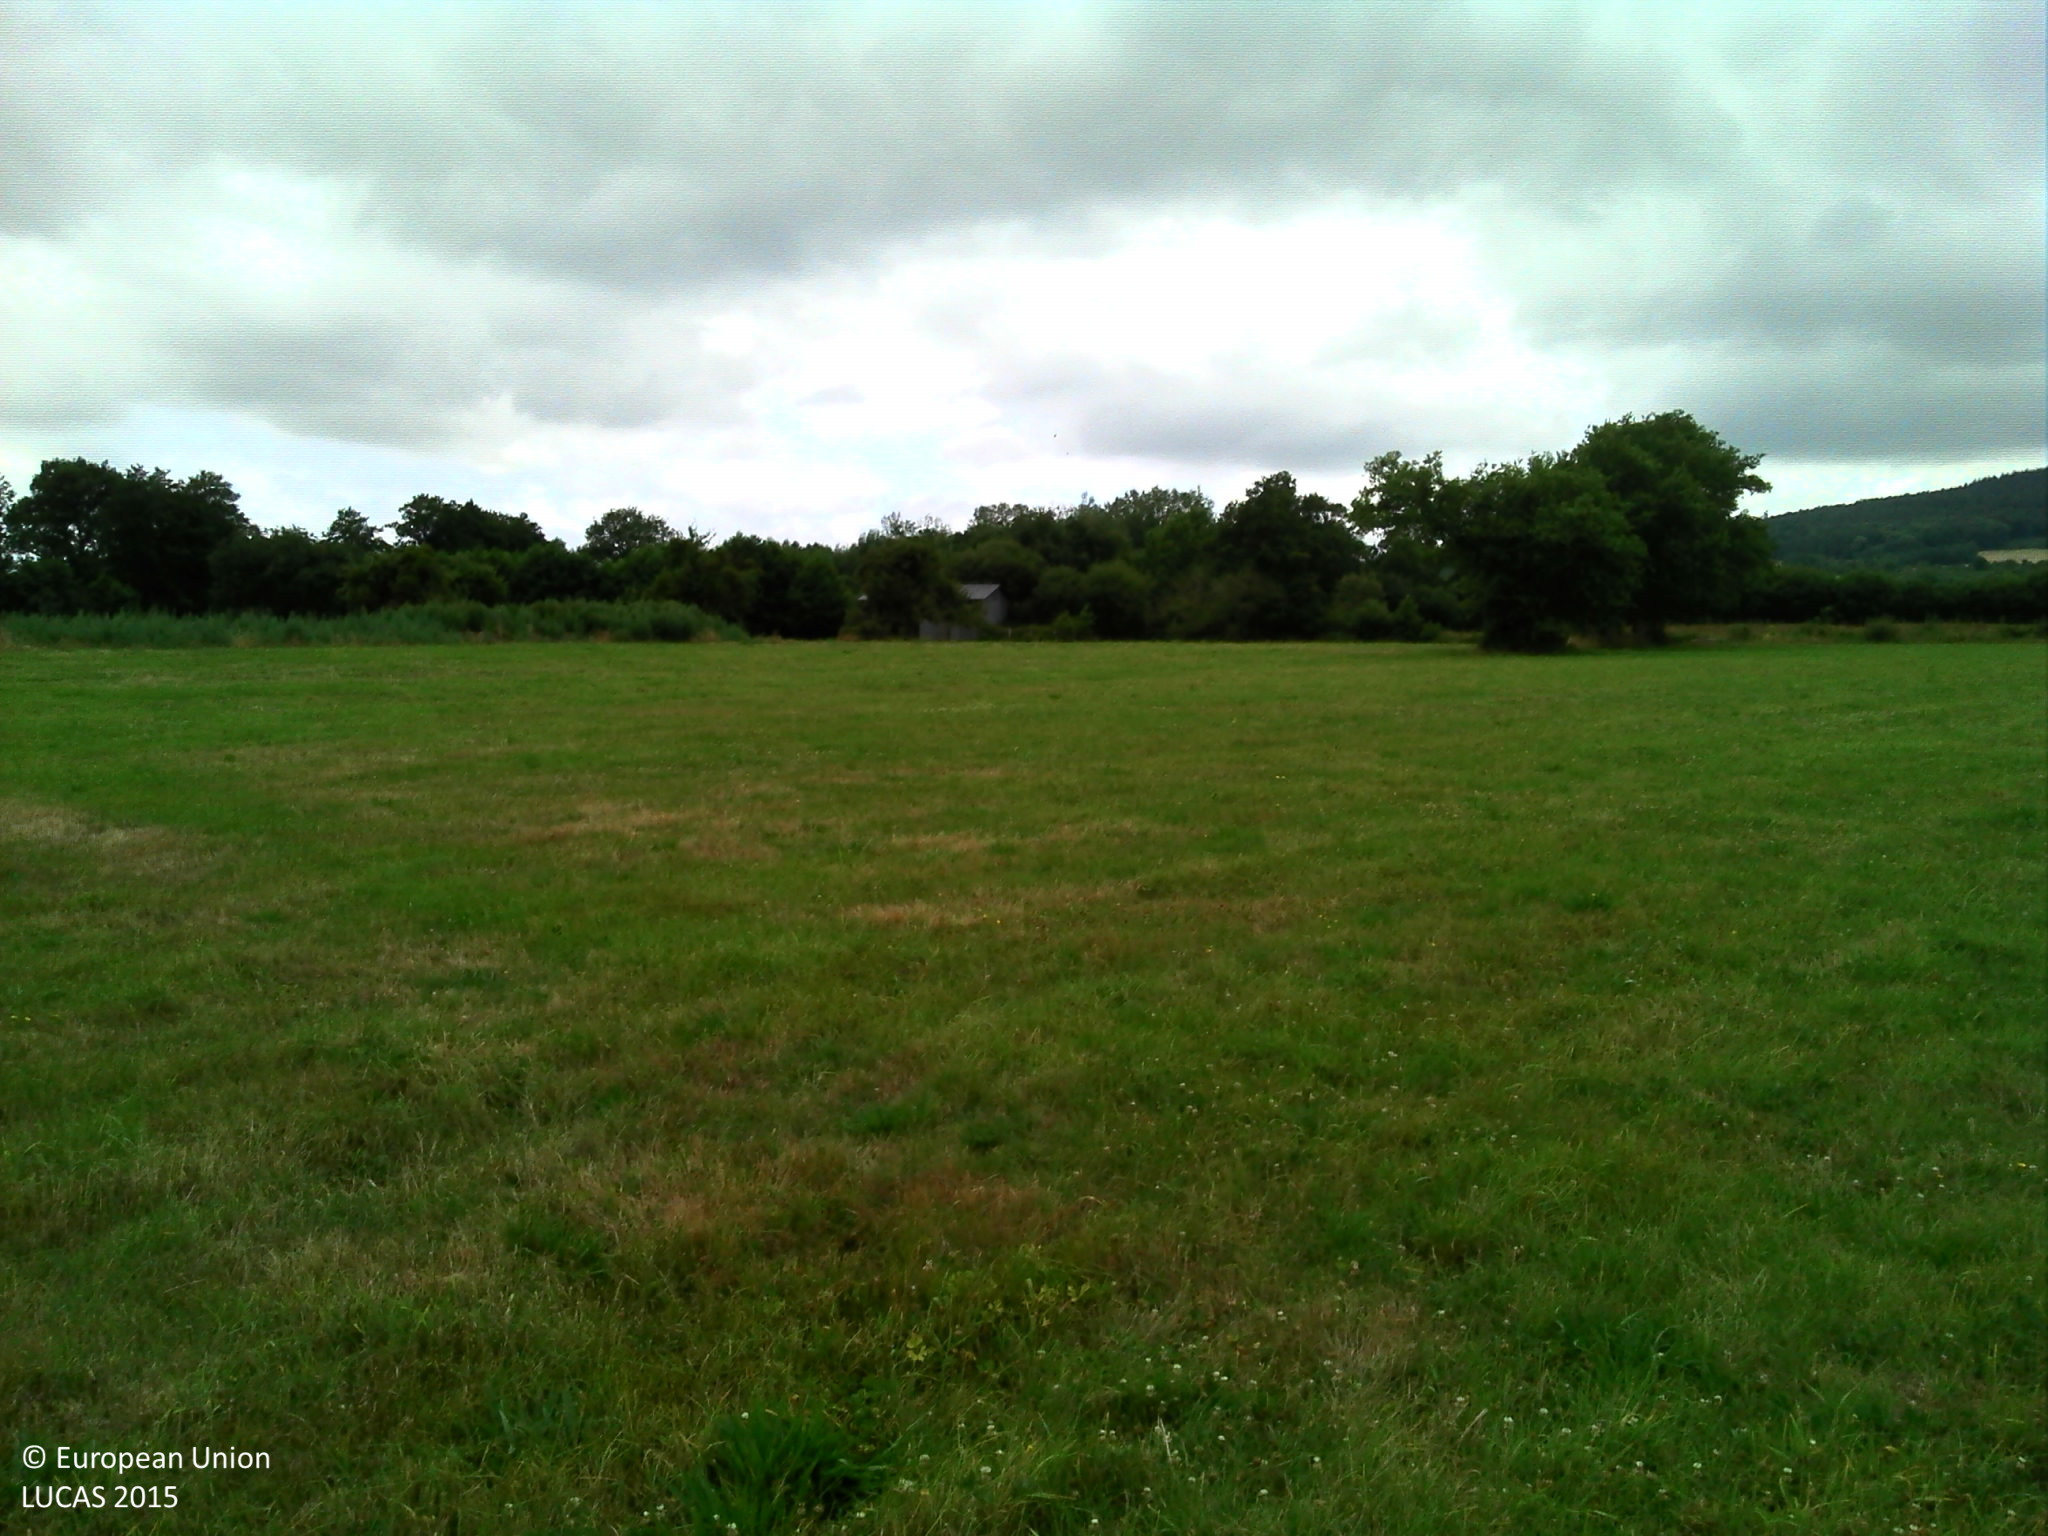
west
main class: Grassland
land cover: Grassland without tree/shrub cover
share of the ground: > 75 %
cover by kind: herbaceous plants 100 %
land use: Agriculture (excluding fallow land and kitchen gardens)
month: July
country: FR
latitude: 48.4320
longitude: -0.0722
